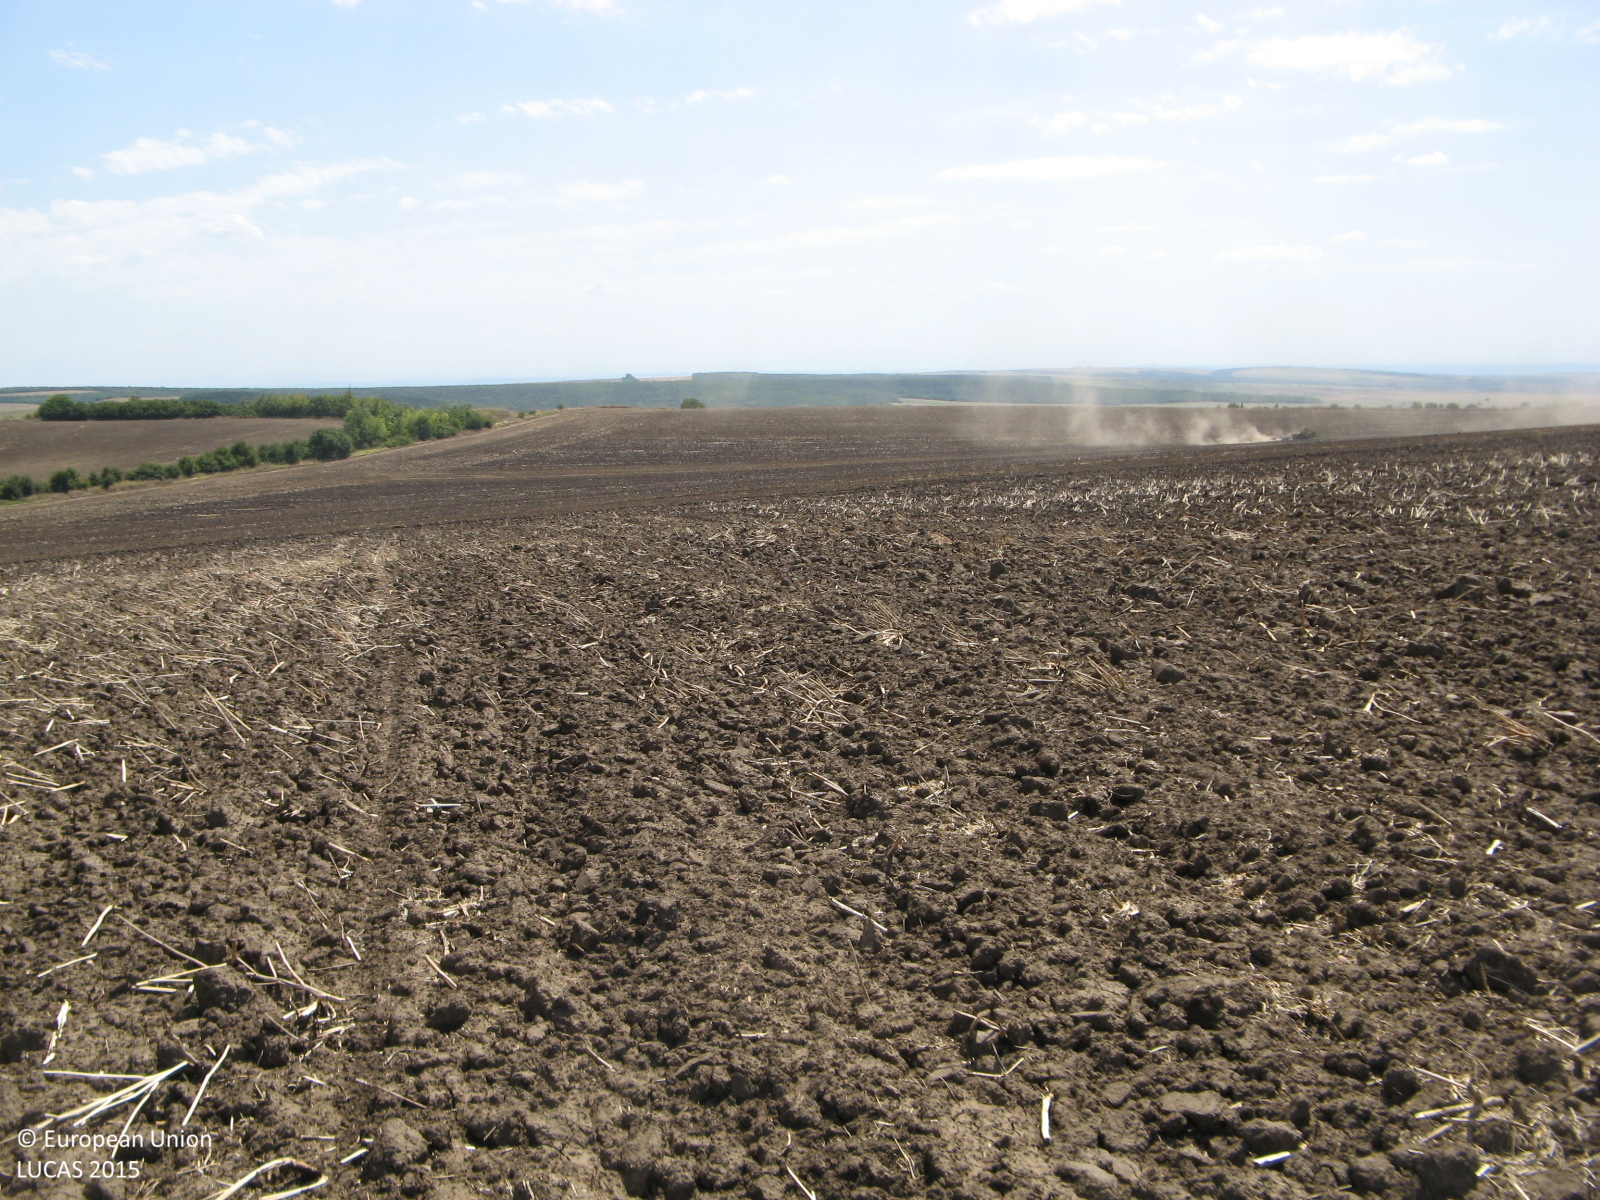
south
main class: Cropland
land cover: Rape and turnip rape
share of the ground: < 10 %
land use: Agriculture (excluding fallow land and kitchen gardens)
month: August
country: BG
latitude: 43.4797
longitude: 25.3215
